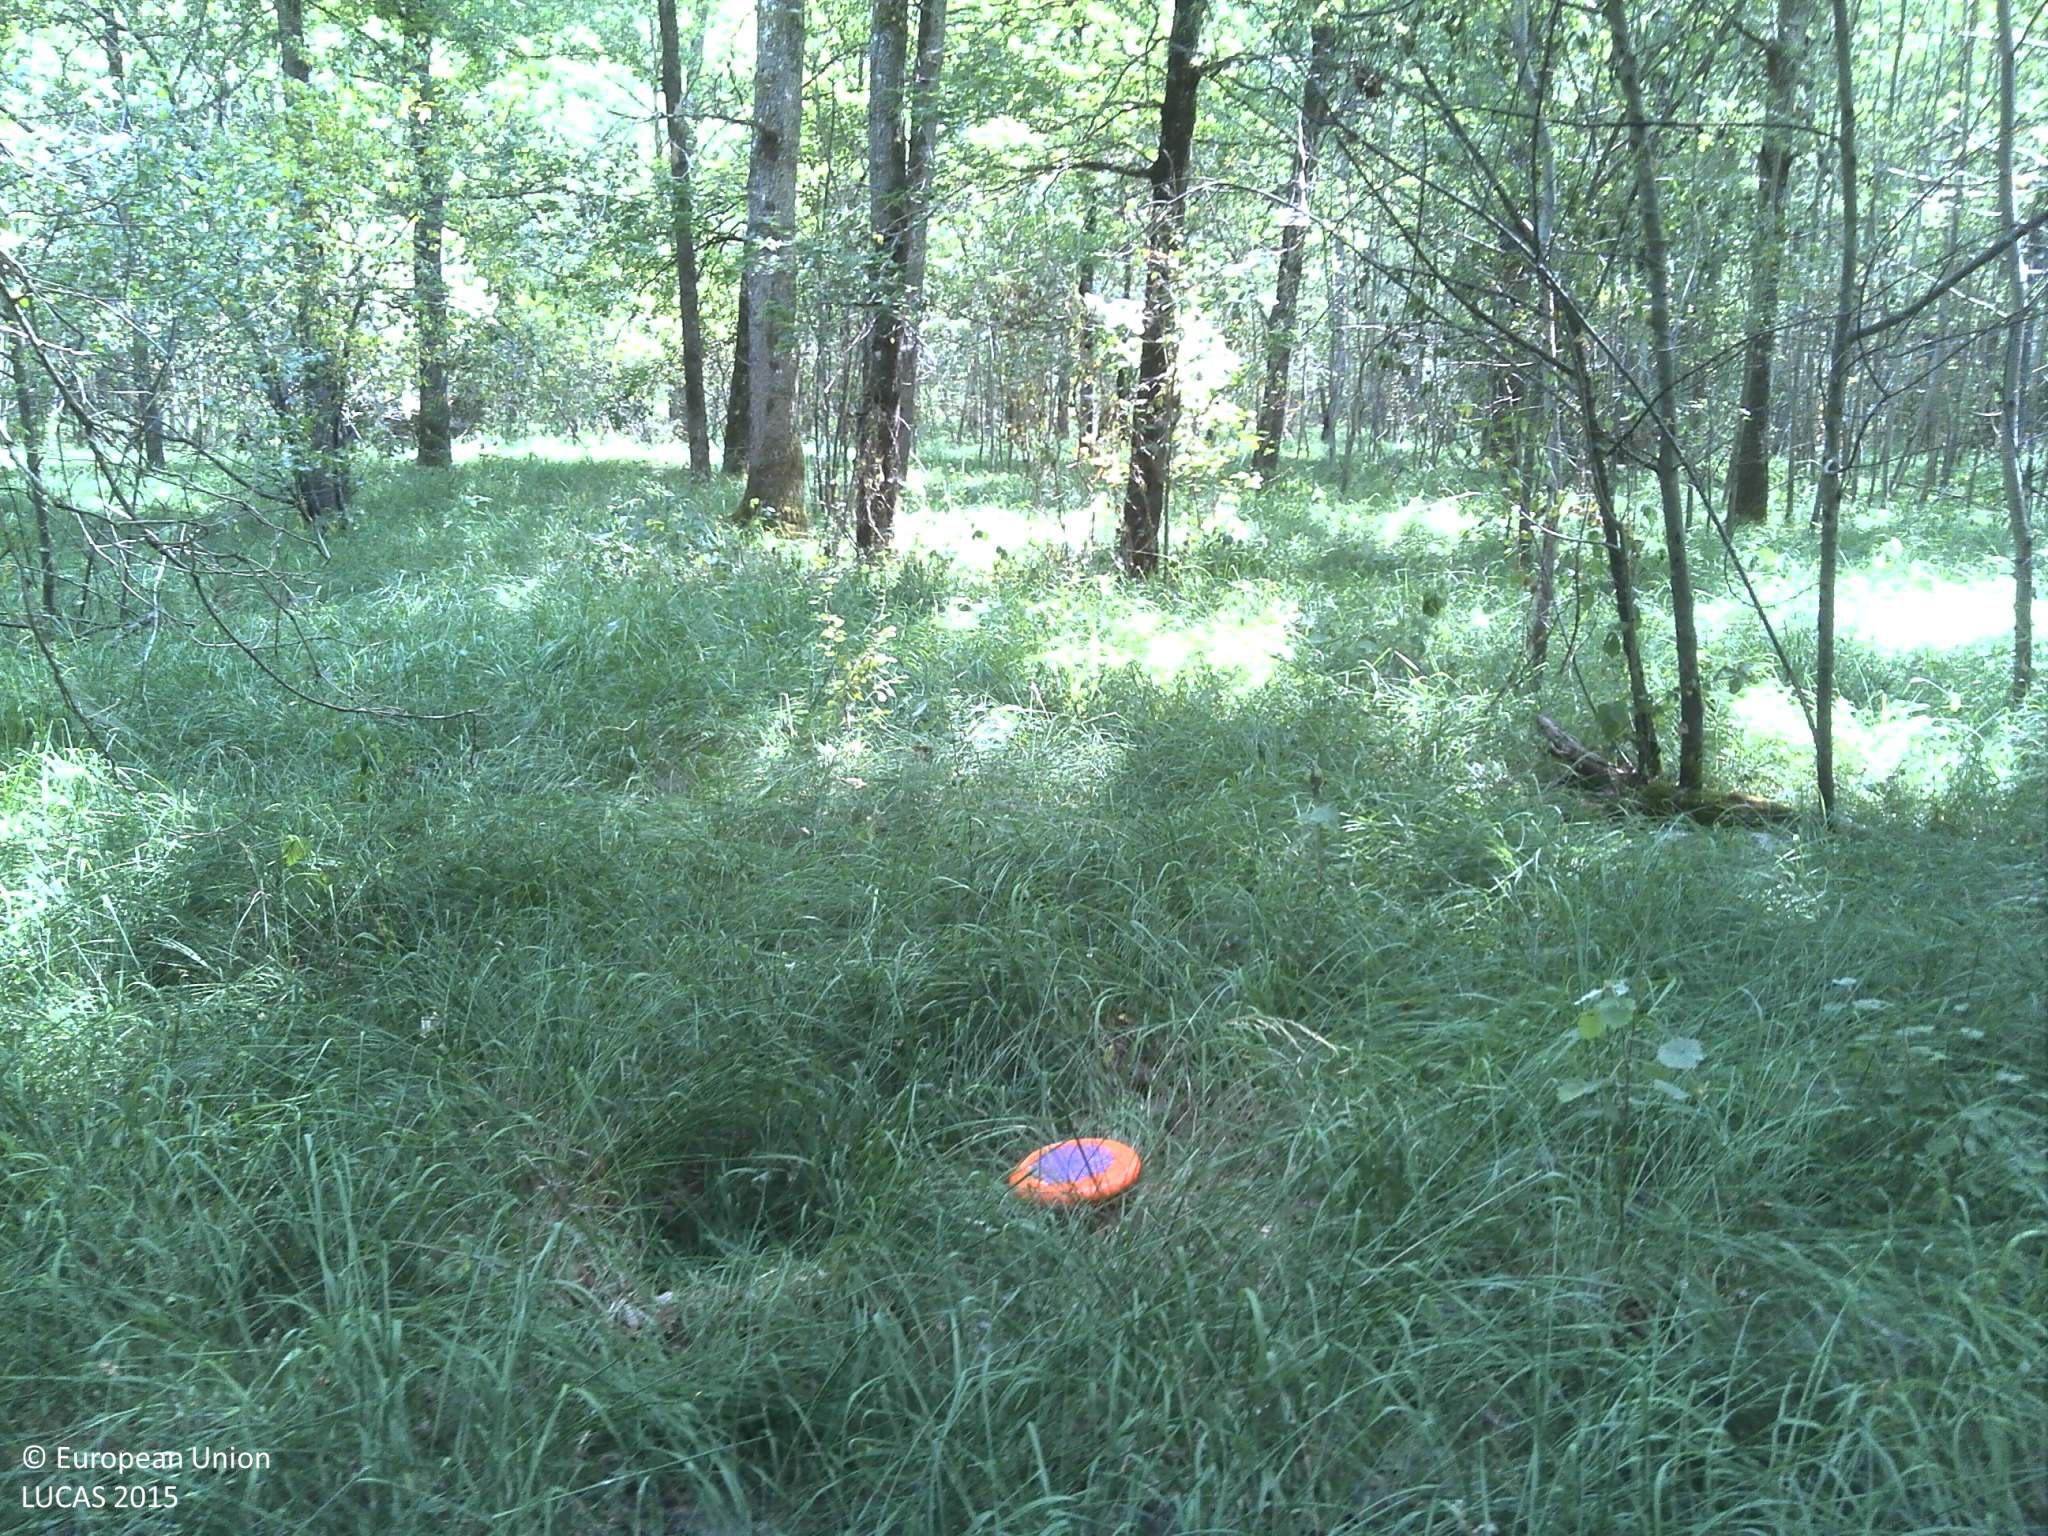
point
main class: Woodland
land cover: Broadleaved woodland
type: acidophilous oak and oak-birch forest
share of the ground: > 75 %
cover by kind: broadleaved forest trees 80 %, herbaceous plants 15 %, shrubs 5 %
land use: Forestry
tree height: > 5 m
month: July
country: FR
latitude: 45.8447
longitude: 4.0919
